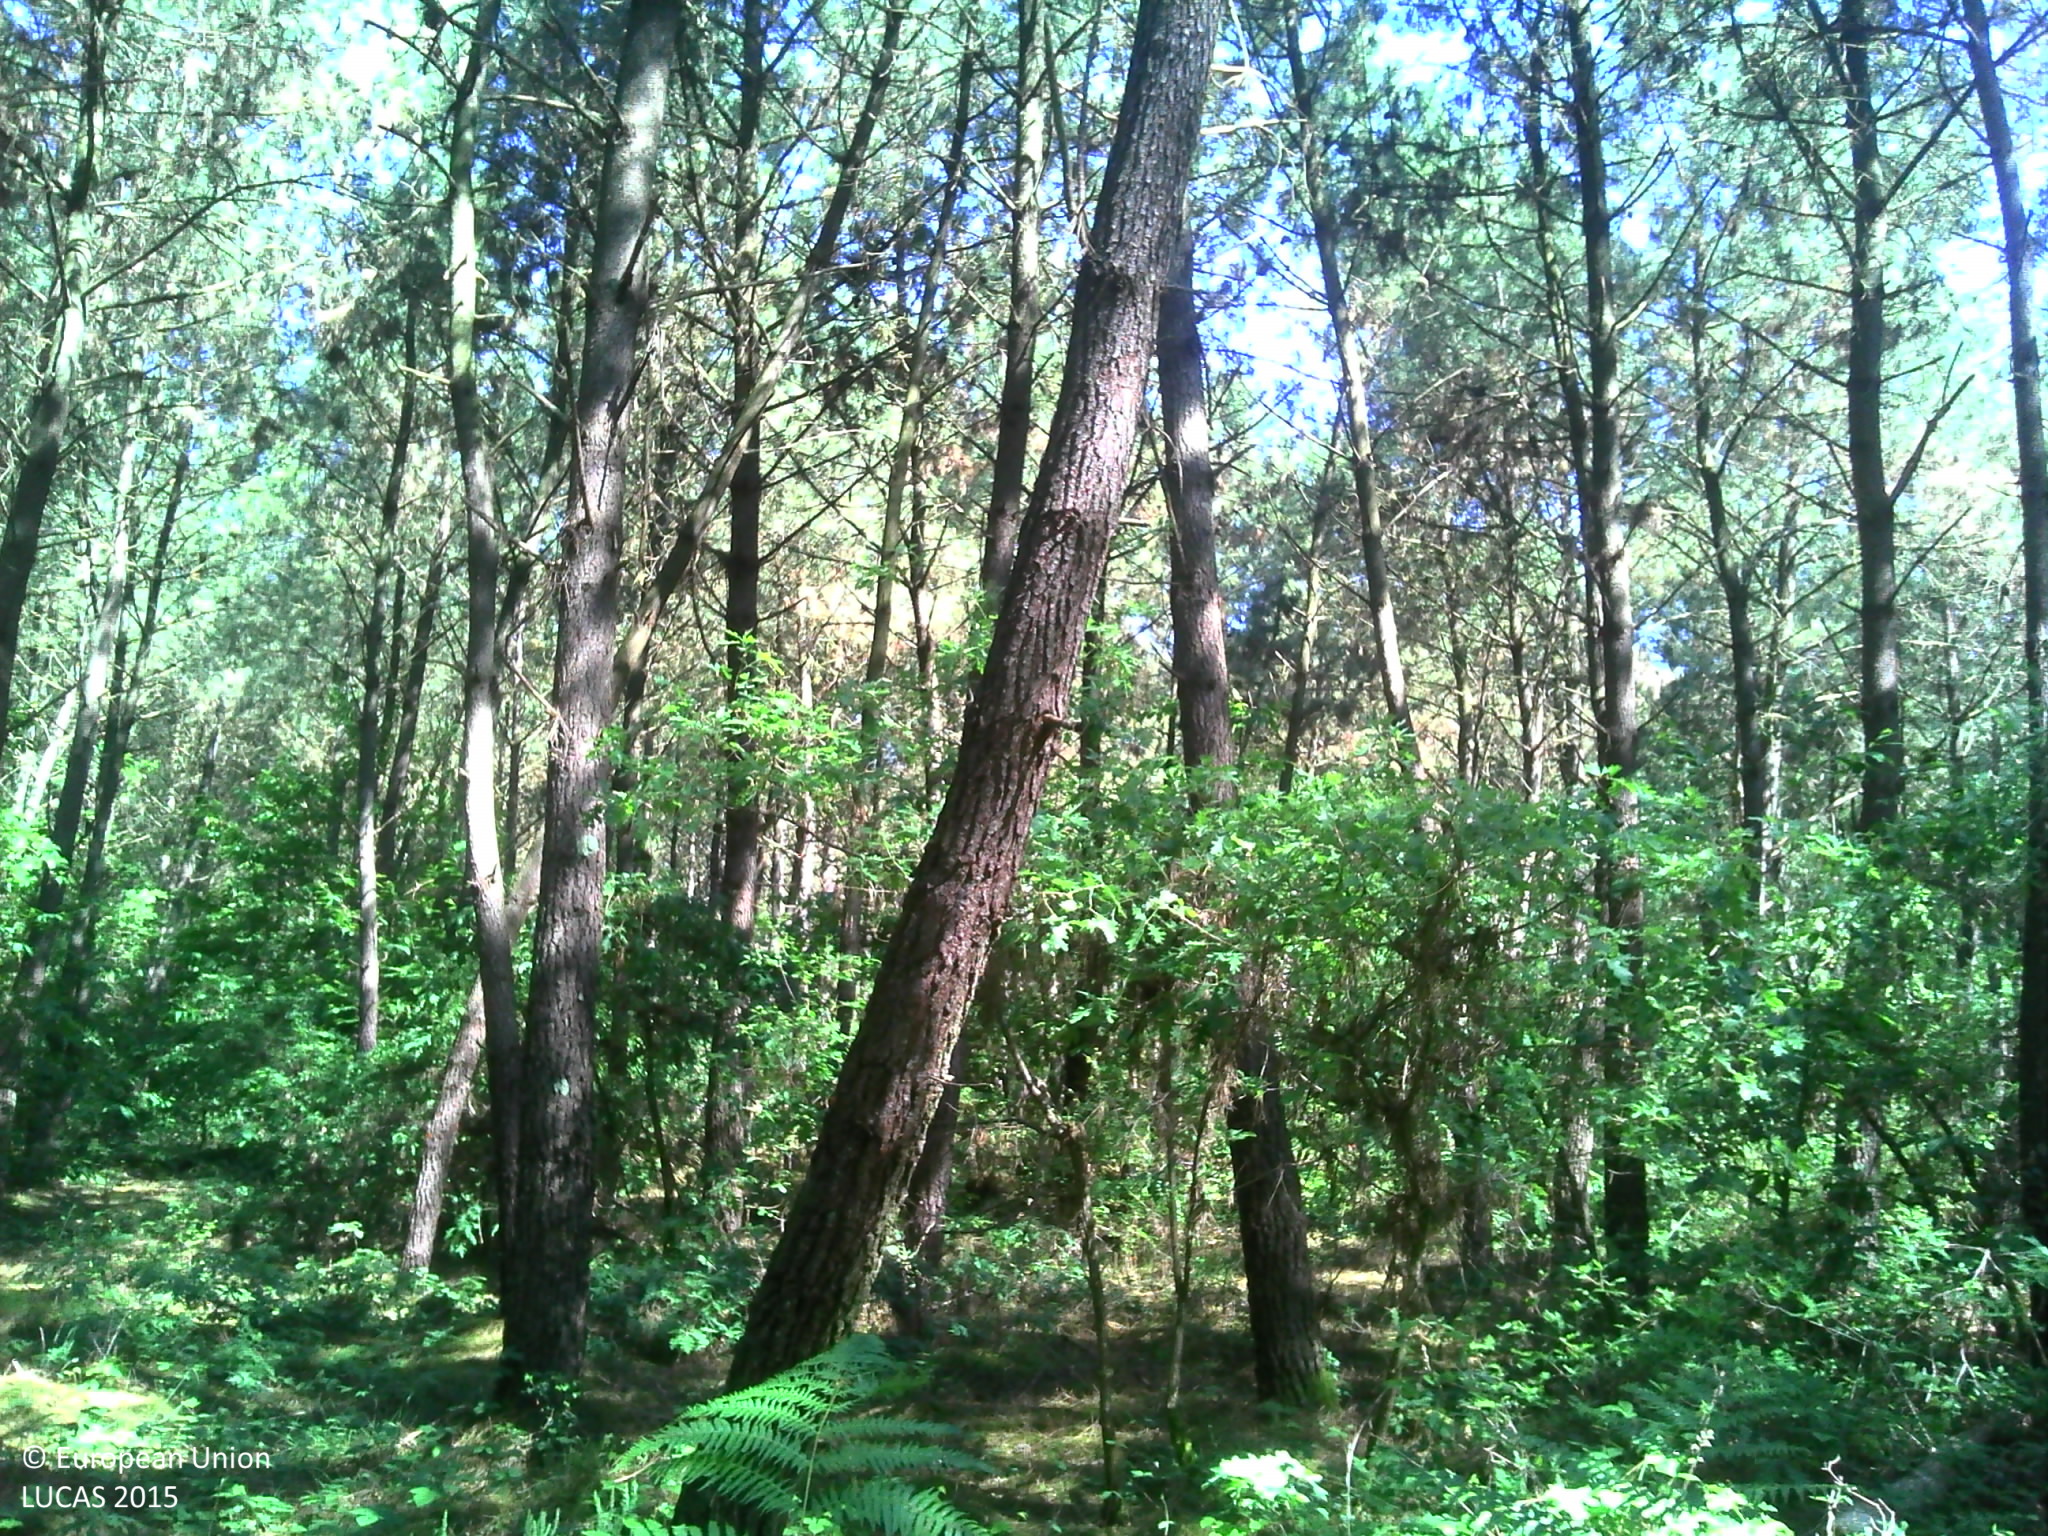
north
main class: Woodland
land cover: Pine dominated mixed woodland
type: hemiboreal forest and nemoral coniferous forest and mixed broadleaved-coniferous forest
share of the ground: > 75 %
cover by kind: coniferous forest trees 40 %, broadleaved forest trees 25 %, shrubs 20 %, herbaceous plants 15 %
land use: Forestry
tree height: > 5 m
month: June
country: FR
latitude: 47.8346
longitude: -0.0613
